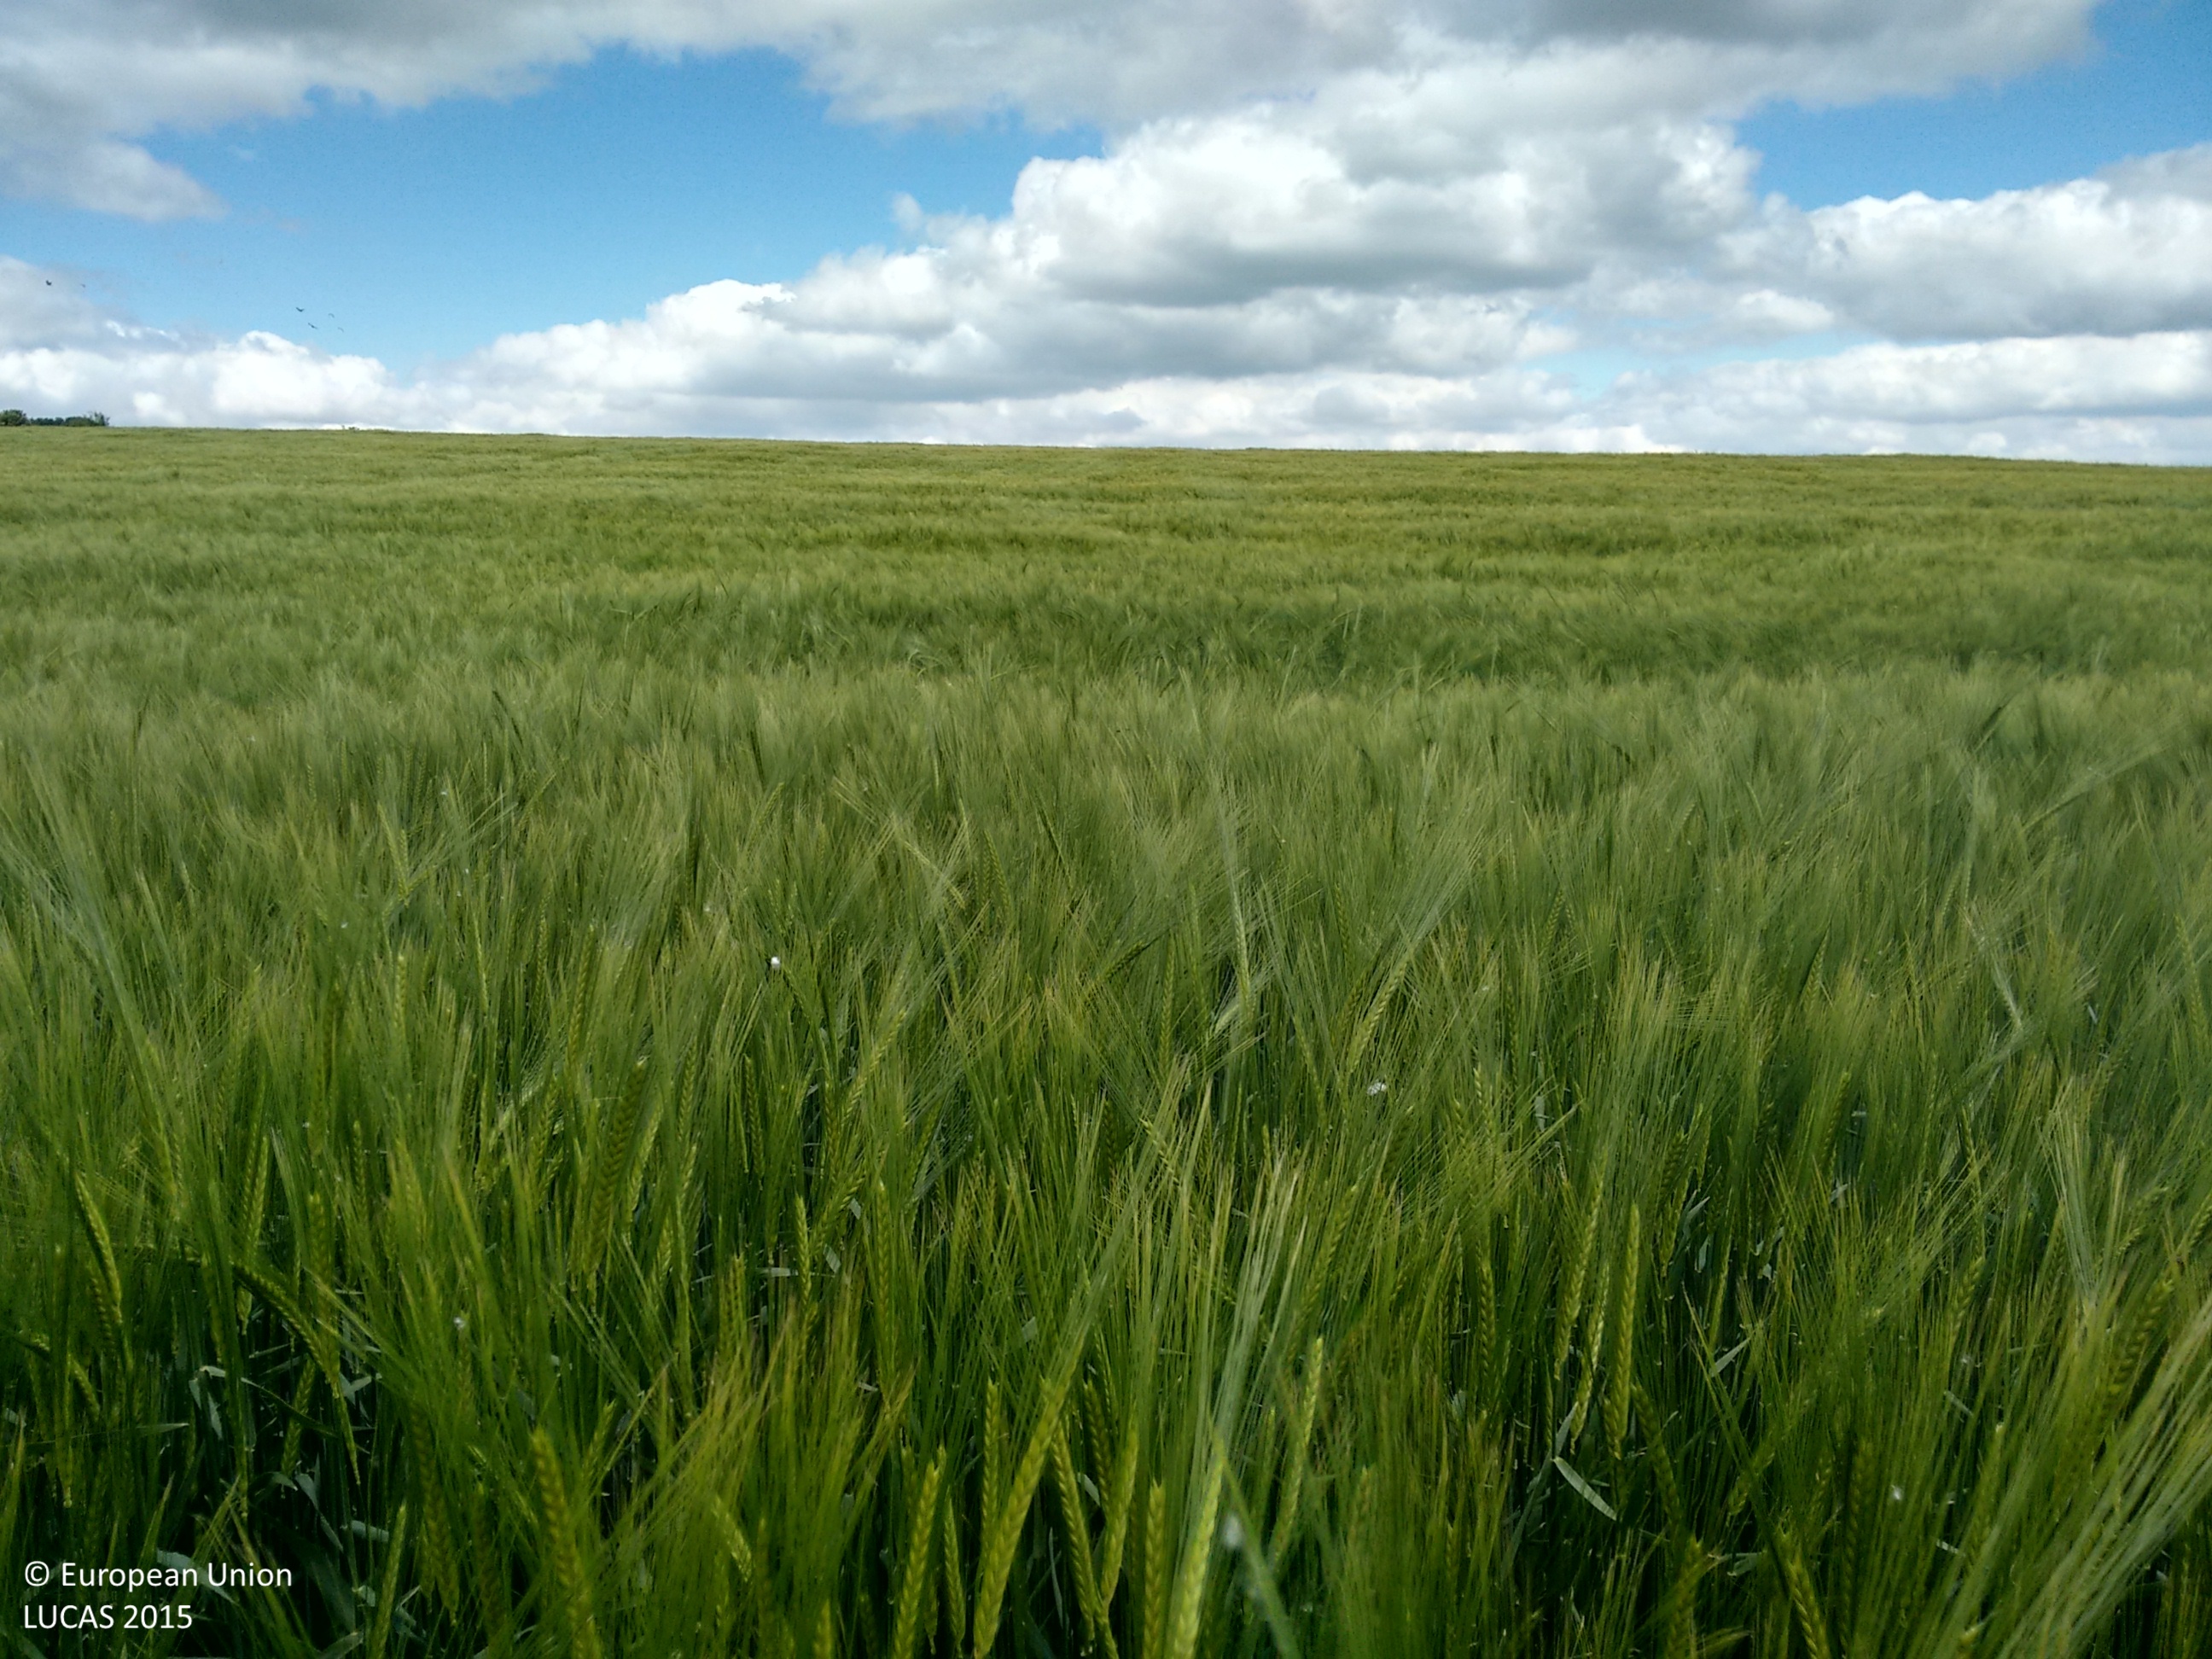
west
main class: Cropland
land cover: Barley
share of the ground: > 75 %
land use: Agriculture (excluding fallow land and kitchen gardens)
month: June
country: GB
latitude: 52.1270
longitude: -1.6662
